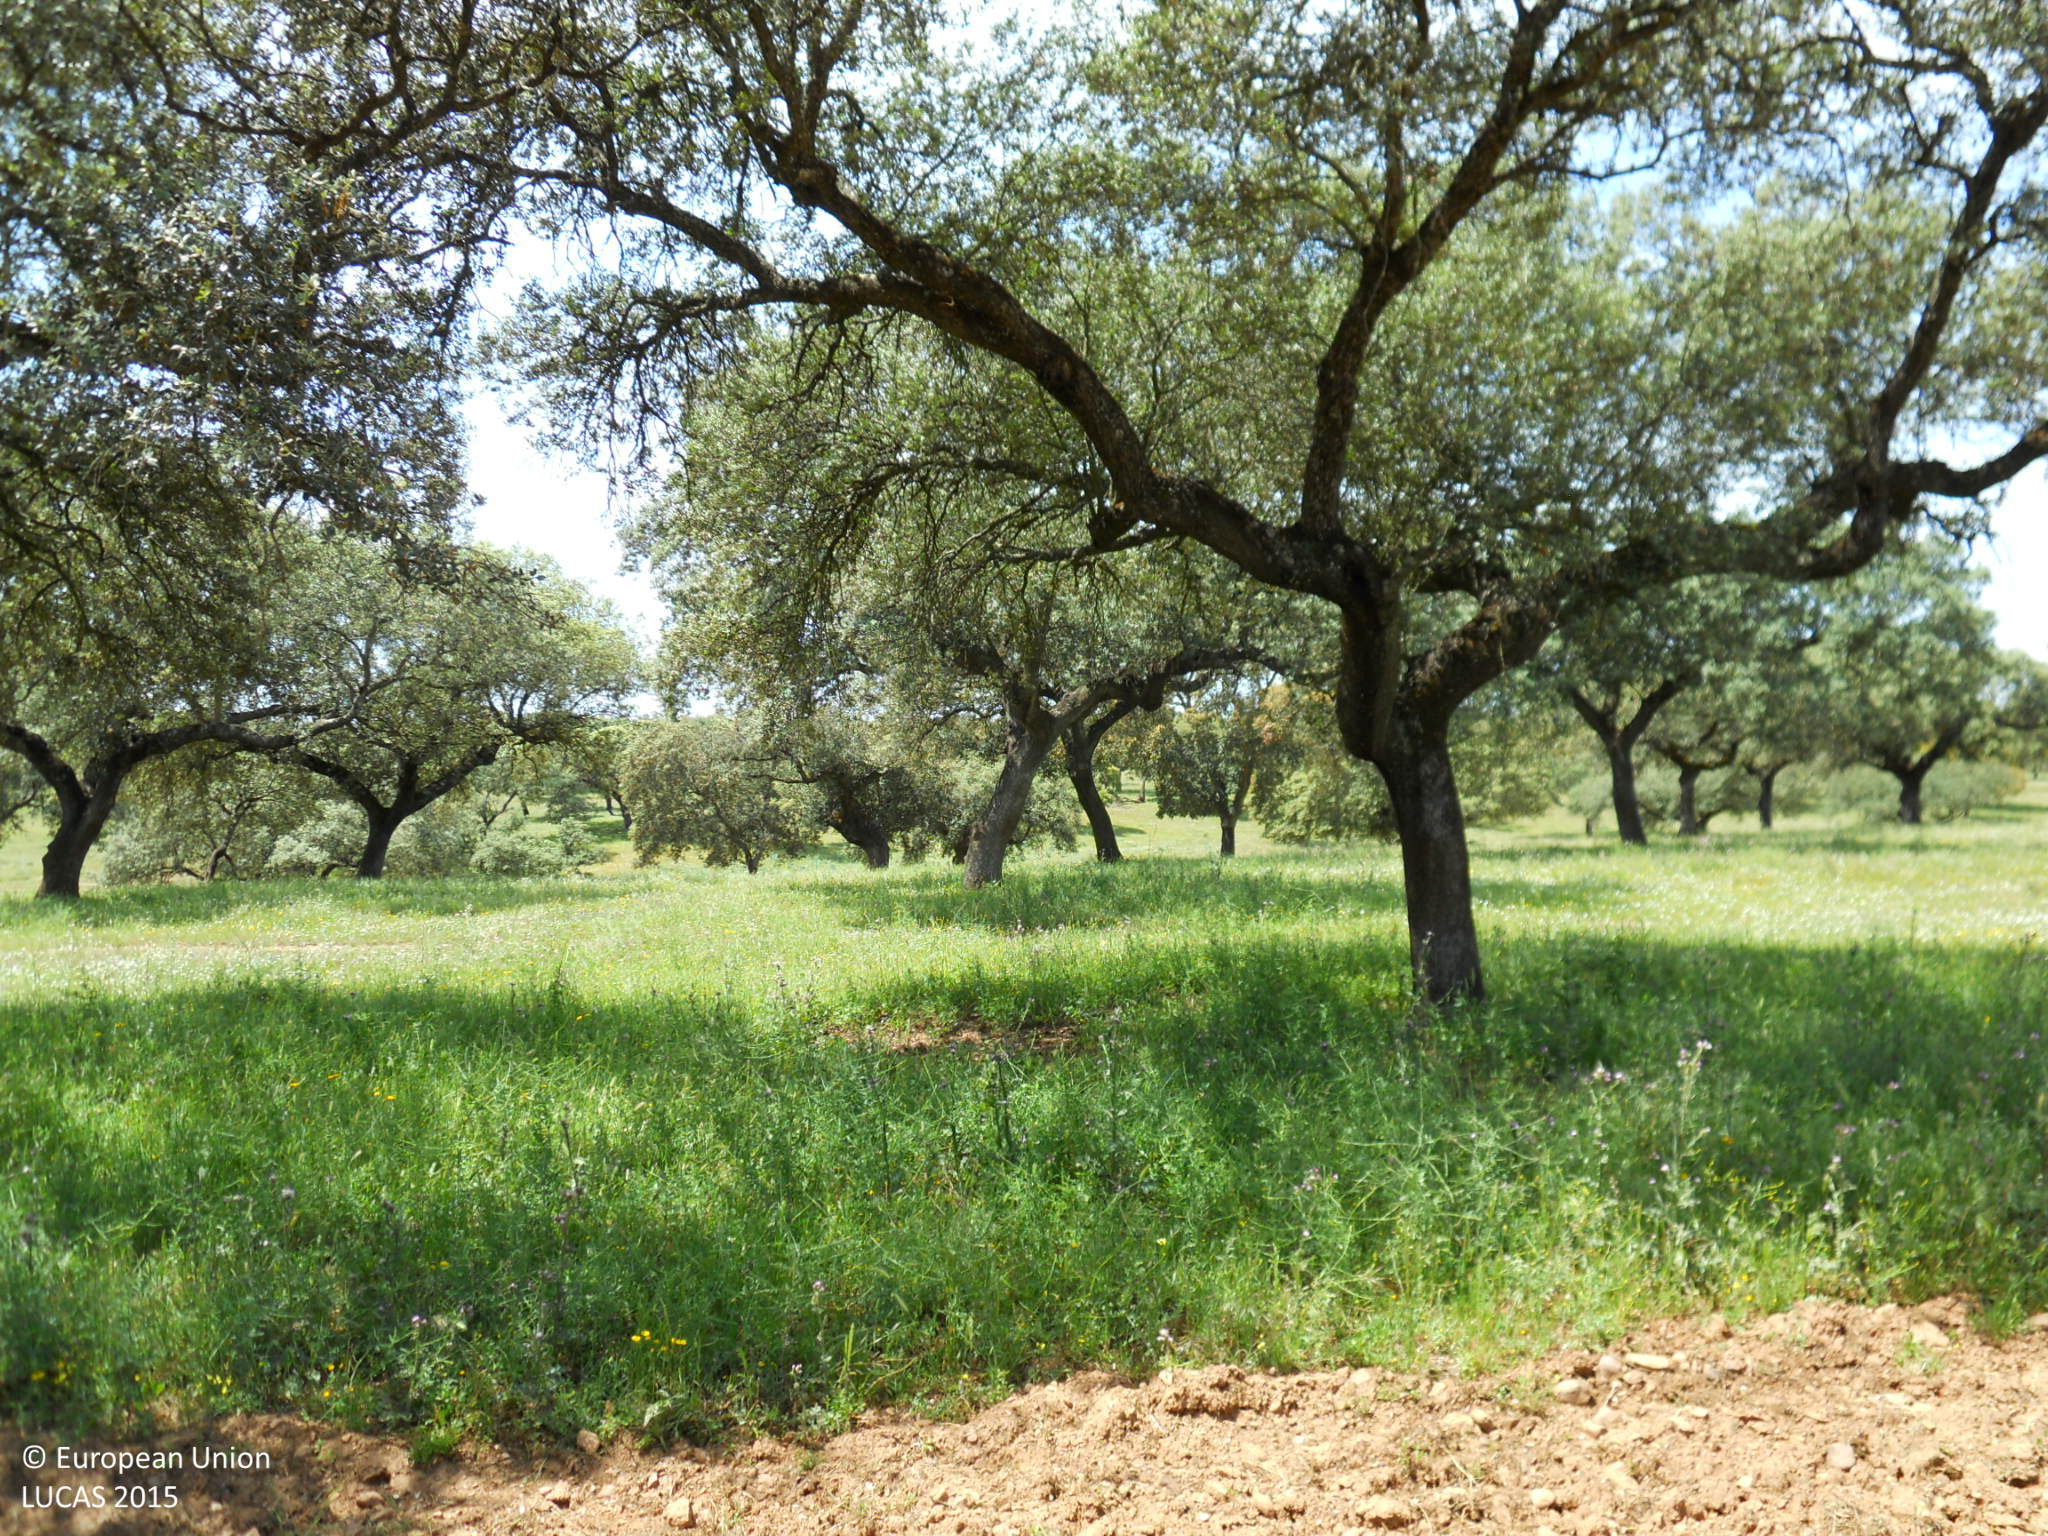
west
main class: Woodland
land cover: Broadleaved woodland
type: broadleaved evergreen forest
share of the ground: > 75 %
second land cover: Grassland without tree/shrub cover
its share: 10 - 25 %
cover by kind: broadleaved forest trees 75 %, herbaceous plants 20 %, unconsolidated bare surface 5 %
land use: Forestry
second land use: Agriculture (excluding fallow land and kitchen gardens)
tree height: > 5 m
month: April
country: ES
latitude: 39.0247
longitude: -6.9240
